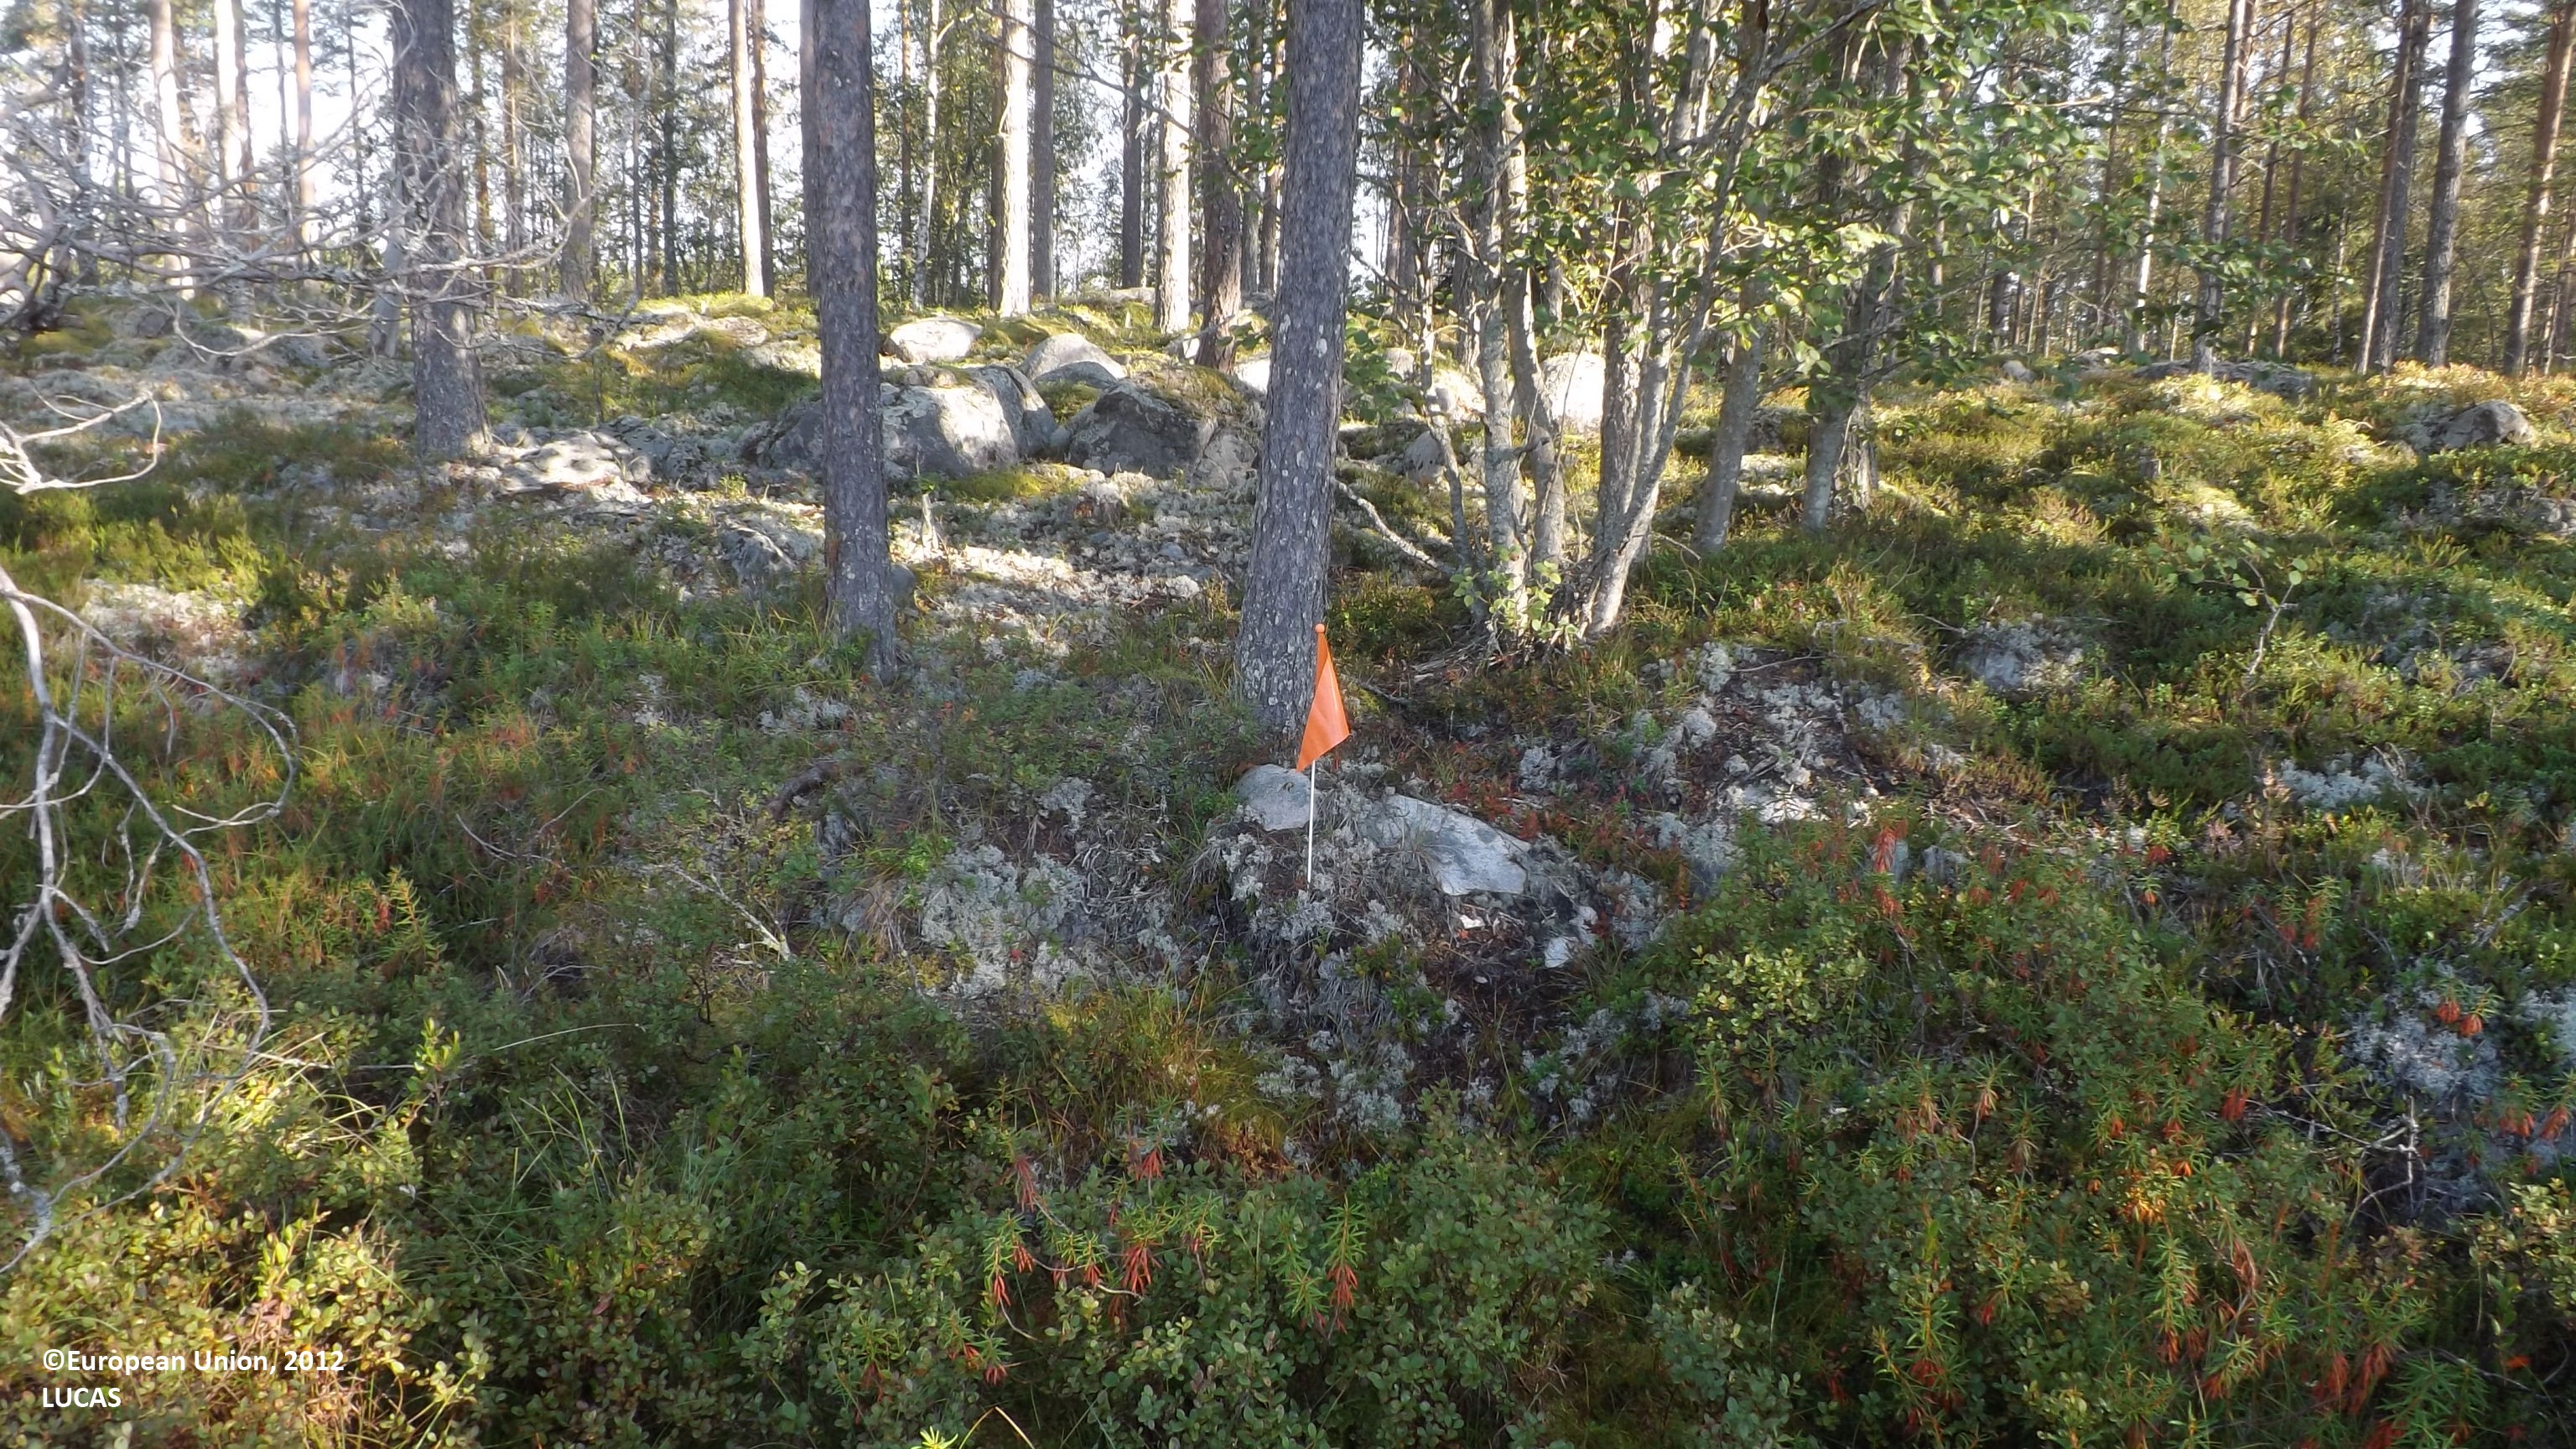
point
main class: Woodland
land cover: Pine dominated coniferous woodland
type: boreal forest
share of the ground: 25 - 50 %
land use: Forestry
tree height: > 5 m
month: August
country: FI
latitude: 63.7486
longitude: 24.0718
